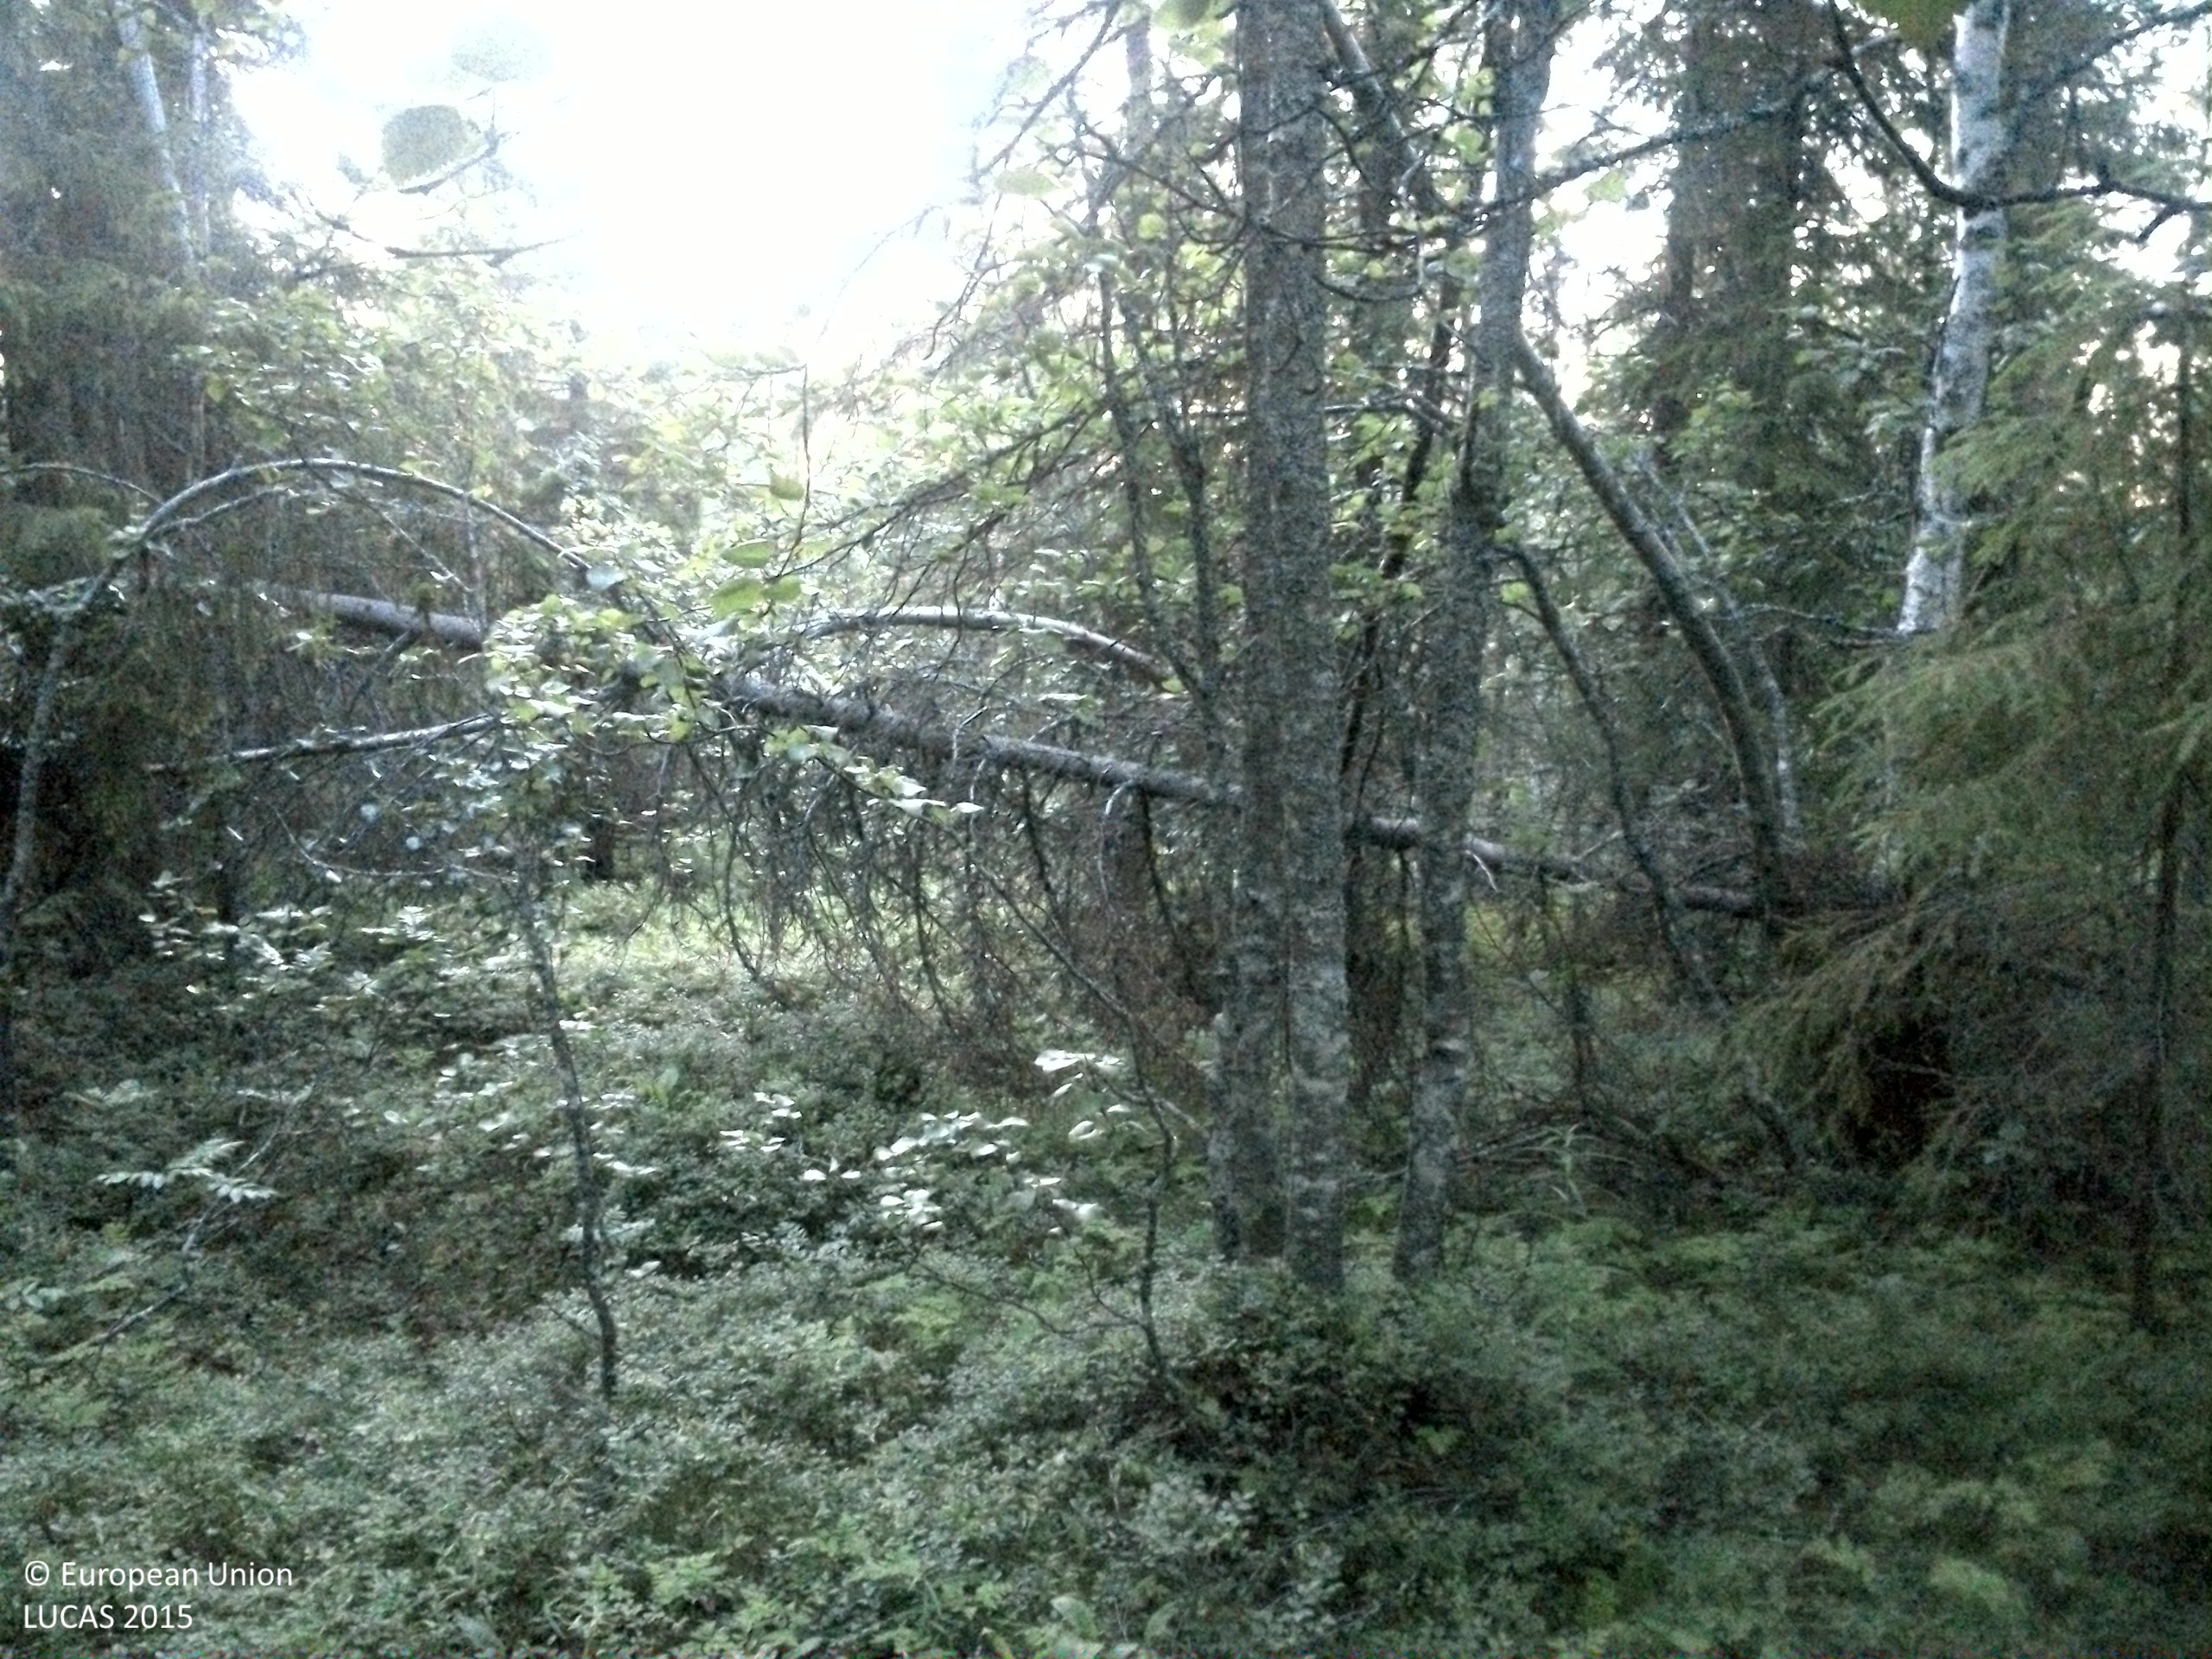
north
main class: Woodland
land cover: Spruce dominated mixed woodland
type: boreal forest
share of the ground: 50 - 75 %
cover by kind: coniferous forest trees 45 %, broadleaved forest trees 25 %, shrubs 20 %, herbaceous plants 5 %, lichens and mosses 5 %
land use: Forestry
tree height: > 5 m
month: July
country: SE
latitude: 64.6045
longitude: 15.6743
